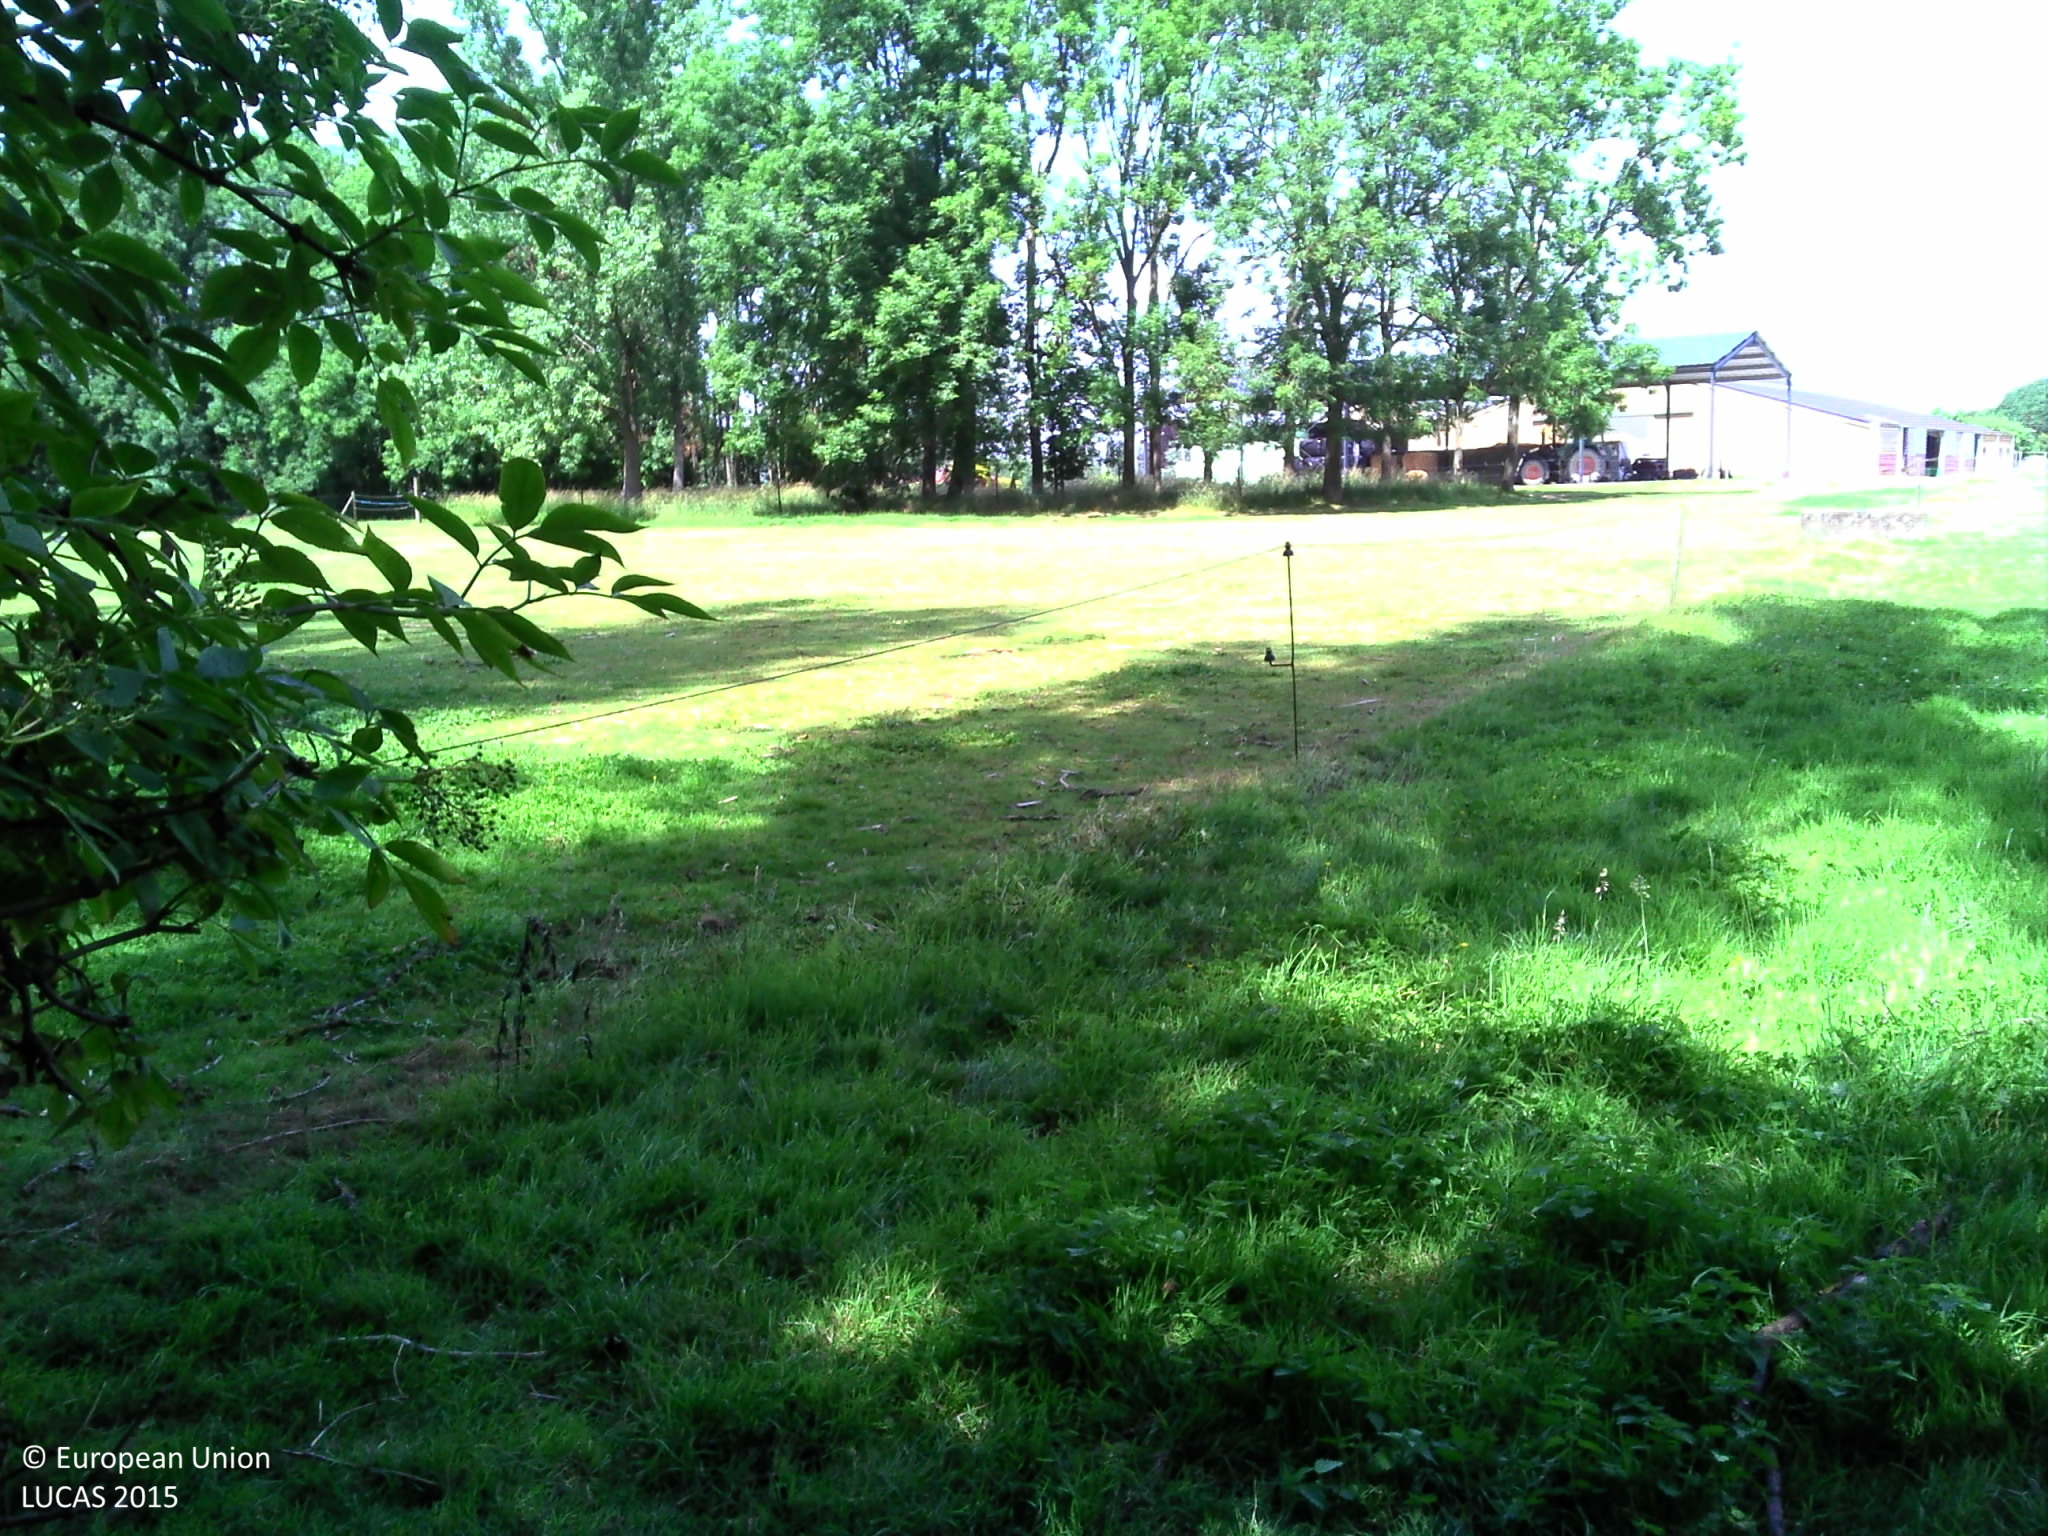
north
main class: Woodland
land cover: Spruce dominated mixed woodland
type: acidophilous oak and oak-birch forest
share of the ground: > 75 %
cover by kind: coniferous forest trees 50 %, herbaceous plants 25 %, broadleaved forest trees 20 %, shrubs 5 %
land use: Forestry
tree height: > 5 m
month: June
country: BE
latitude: 50.5144
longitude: 3.6892
